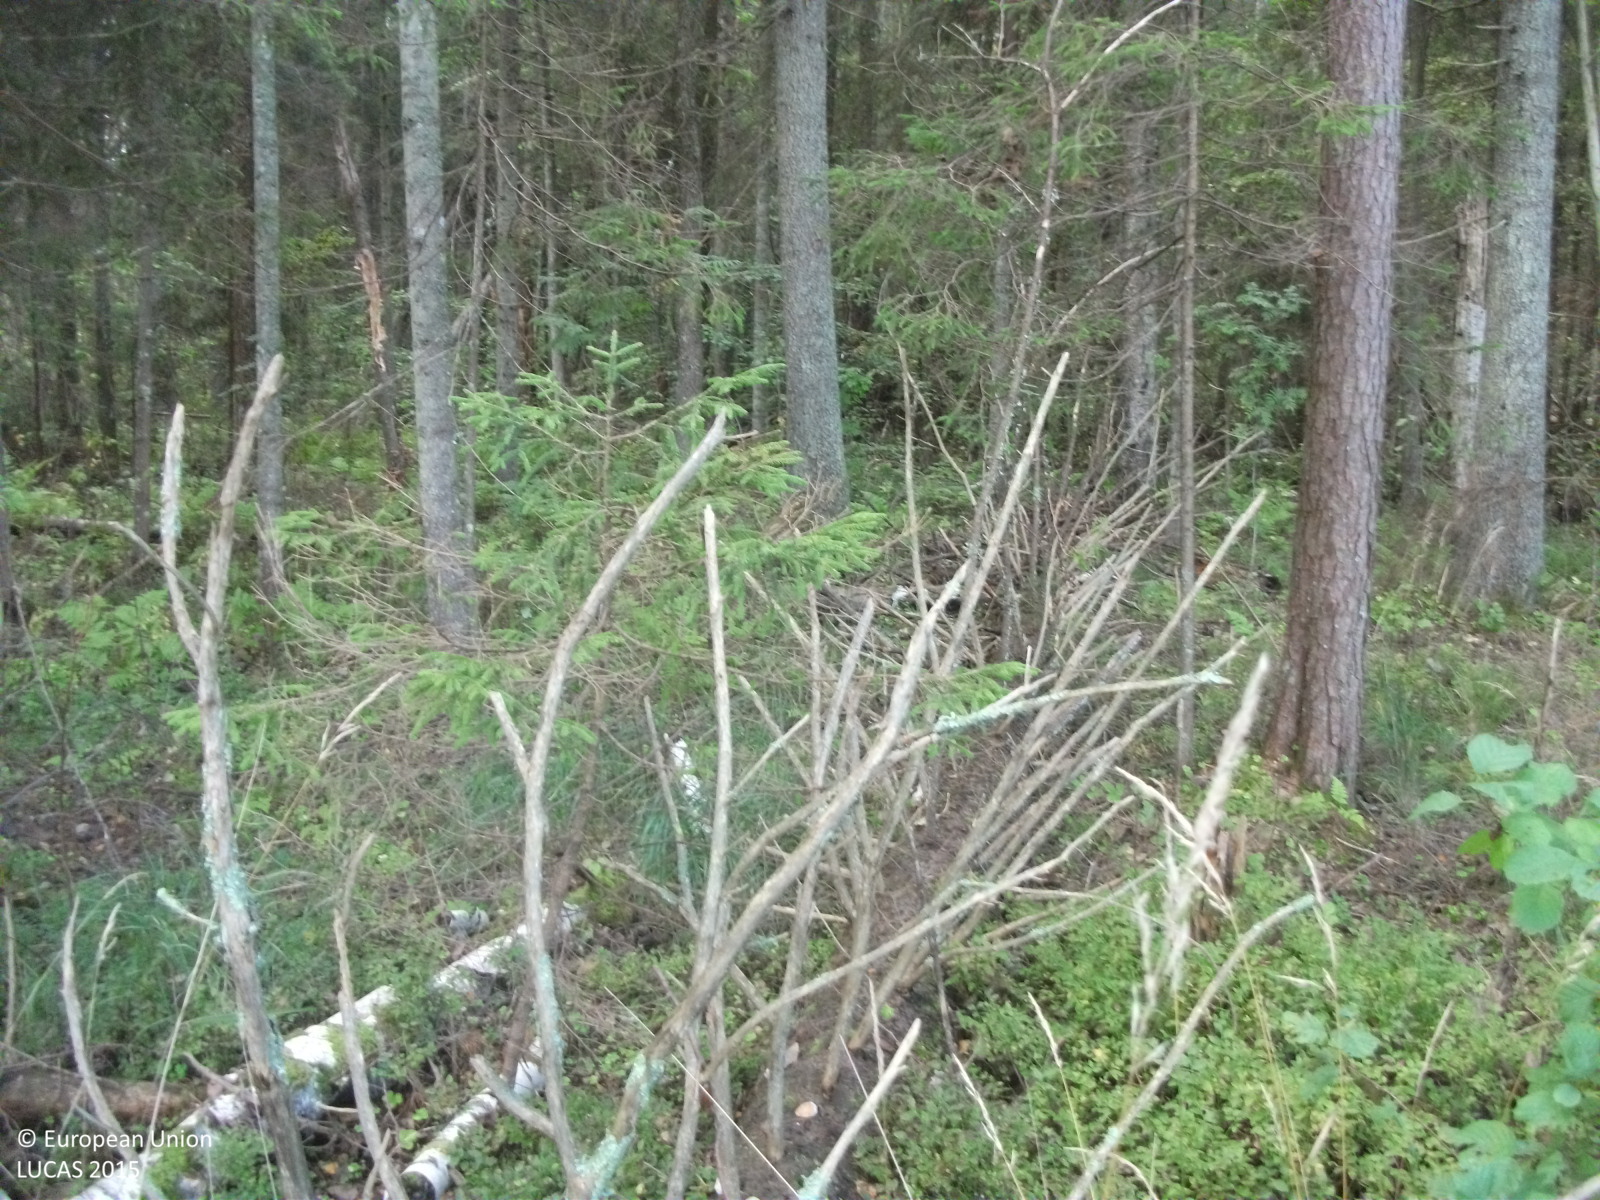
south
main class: Woodland
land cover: Spruce dominated coniferous woodland
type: hemiboreal forest and nemoral coniferous forest and mixed broadleaved-coniferous forest
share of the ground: > 75 %
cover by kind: coniferous forest trees 80 %, broadleaved forest trees 10 %, shrubs 5 %, herbaceous plants 5 %
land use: Forestry
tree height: > 5 m
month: September
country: LV
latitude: 57.9018
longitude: 24.5156
